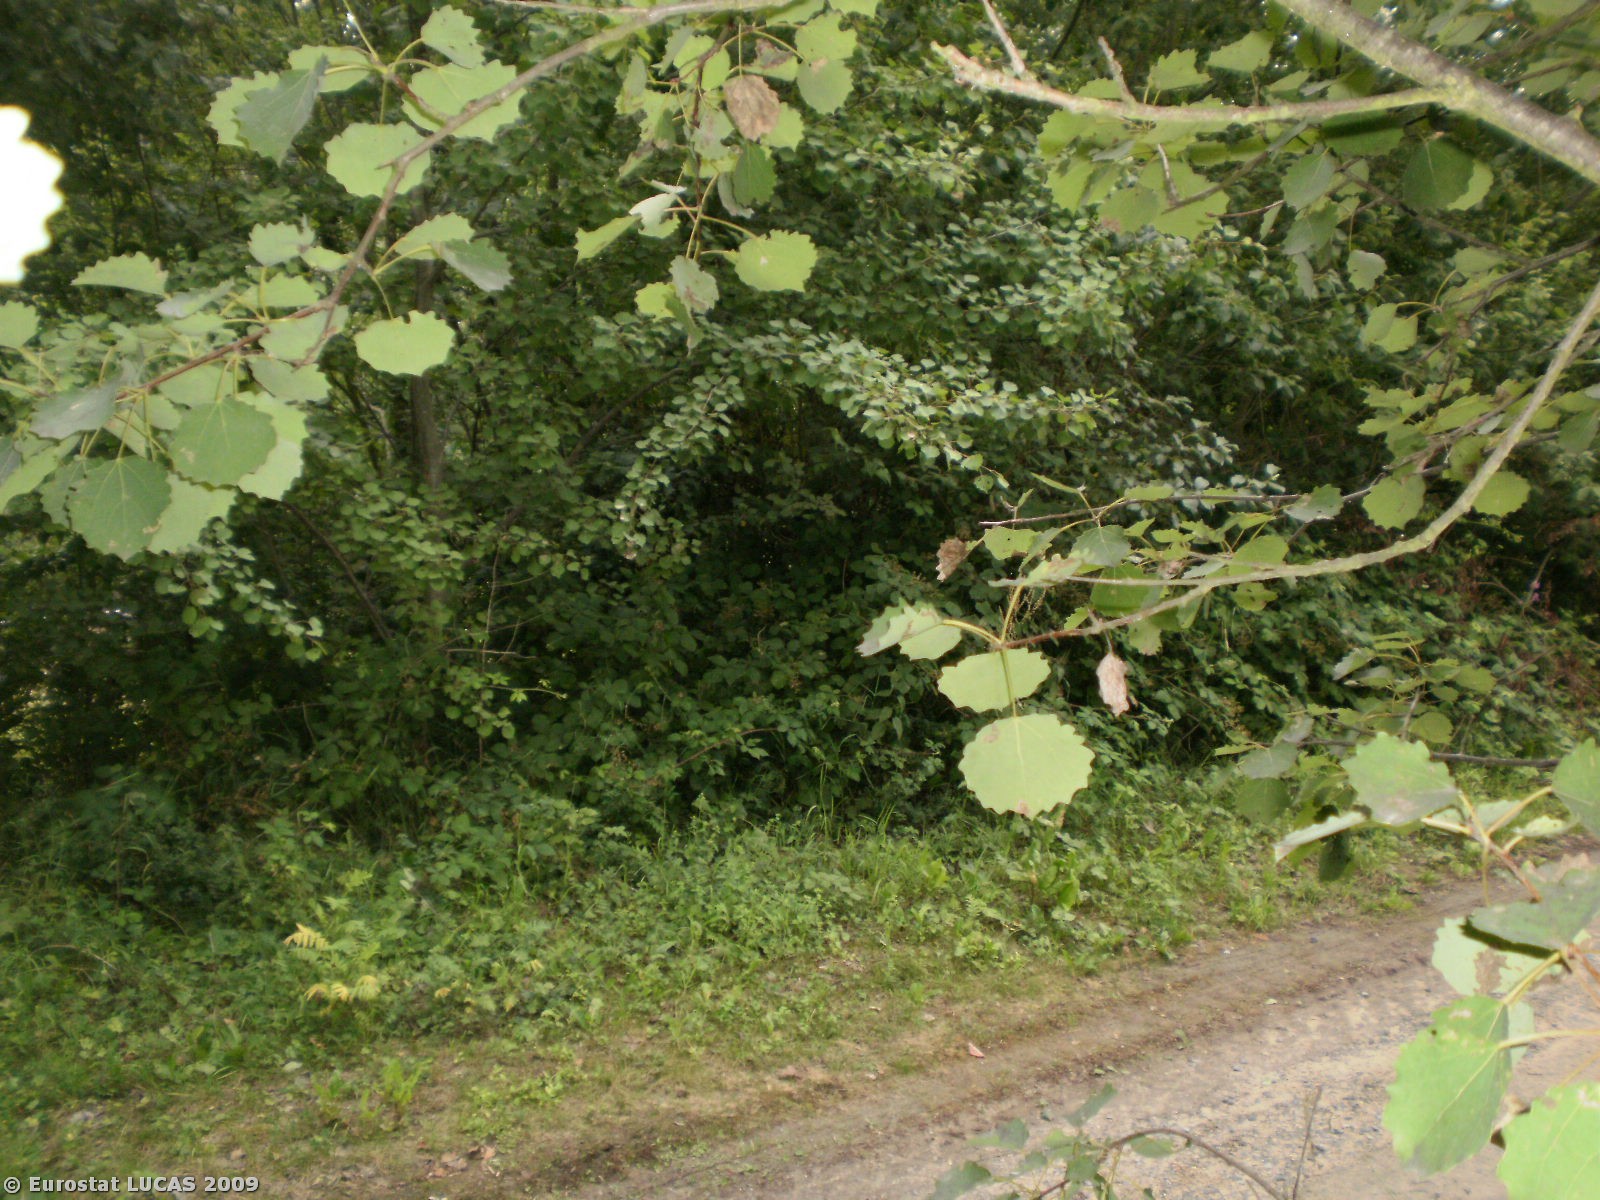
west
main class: Grassland
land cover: Grassland without tree/shrub cover
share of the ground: > 75 %
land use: Agriculture (excluding fallow land and kitchen gardens)
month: July
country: BE
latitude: 50.9202
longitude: 4.2052
